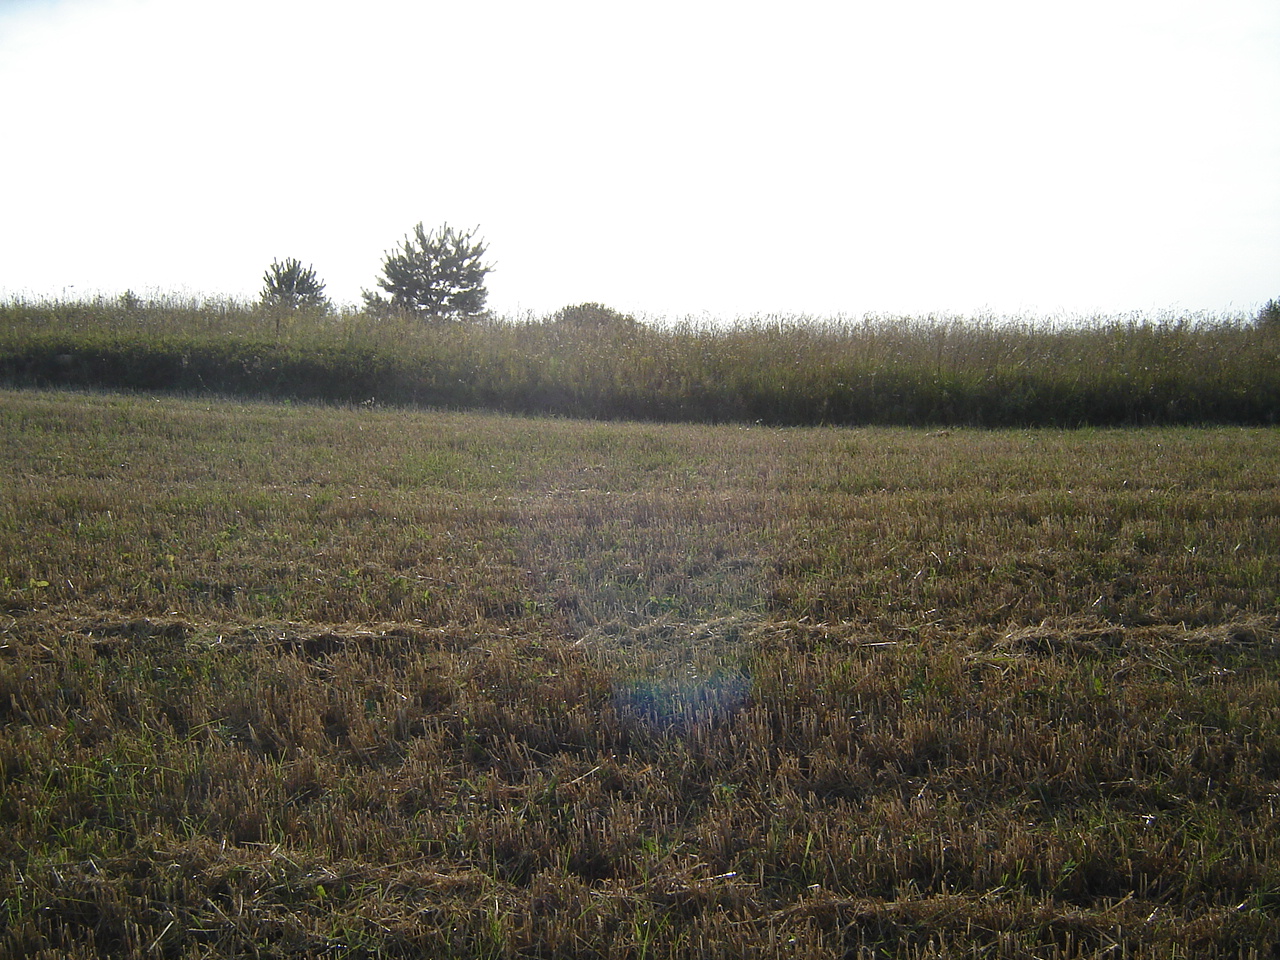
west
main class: Cropland
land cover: Barley
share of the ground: > 75 %
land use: Agriculture (excluding fallow land and kitchen gardens)
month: August
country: LT
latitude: 54.7134
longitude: 24.8412
